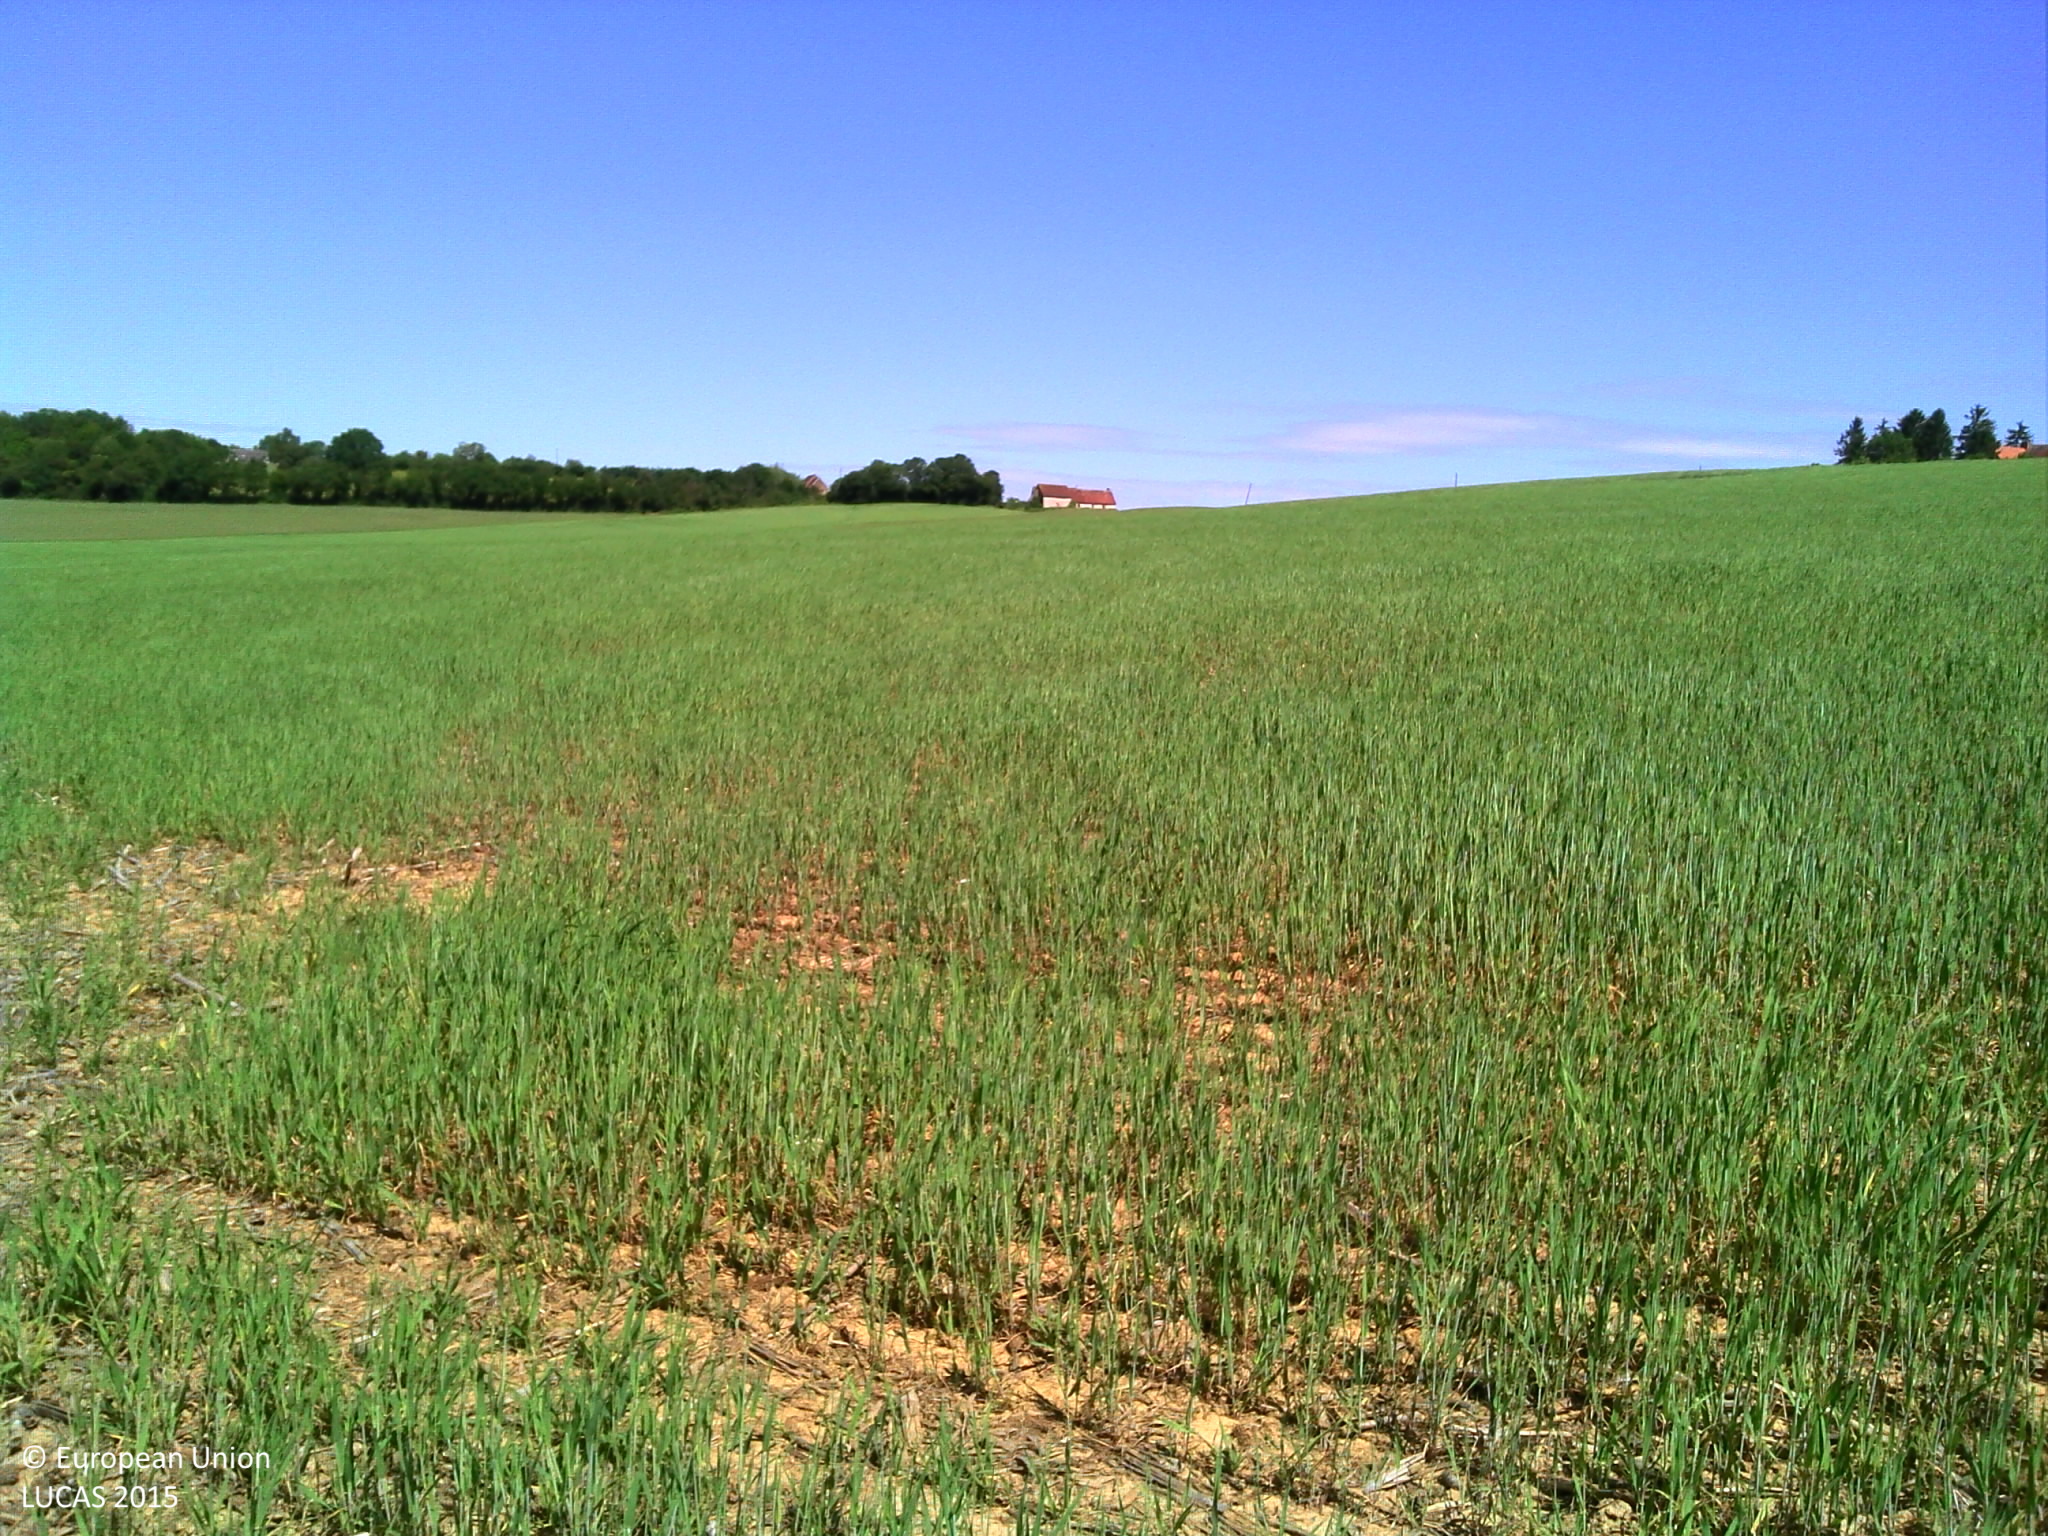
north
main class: Cropland
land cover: Barley
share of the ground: > 75 %
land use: Agriculture (excluding fallow land and kitchen gardens)
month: June
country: FR
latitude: 47.0192
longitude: 2.9042
